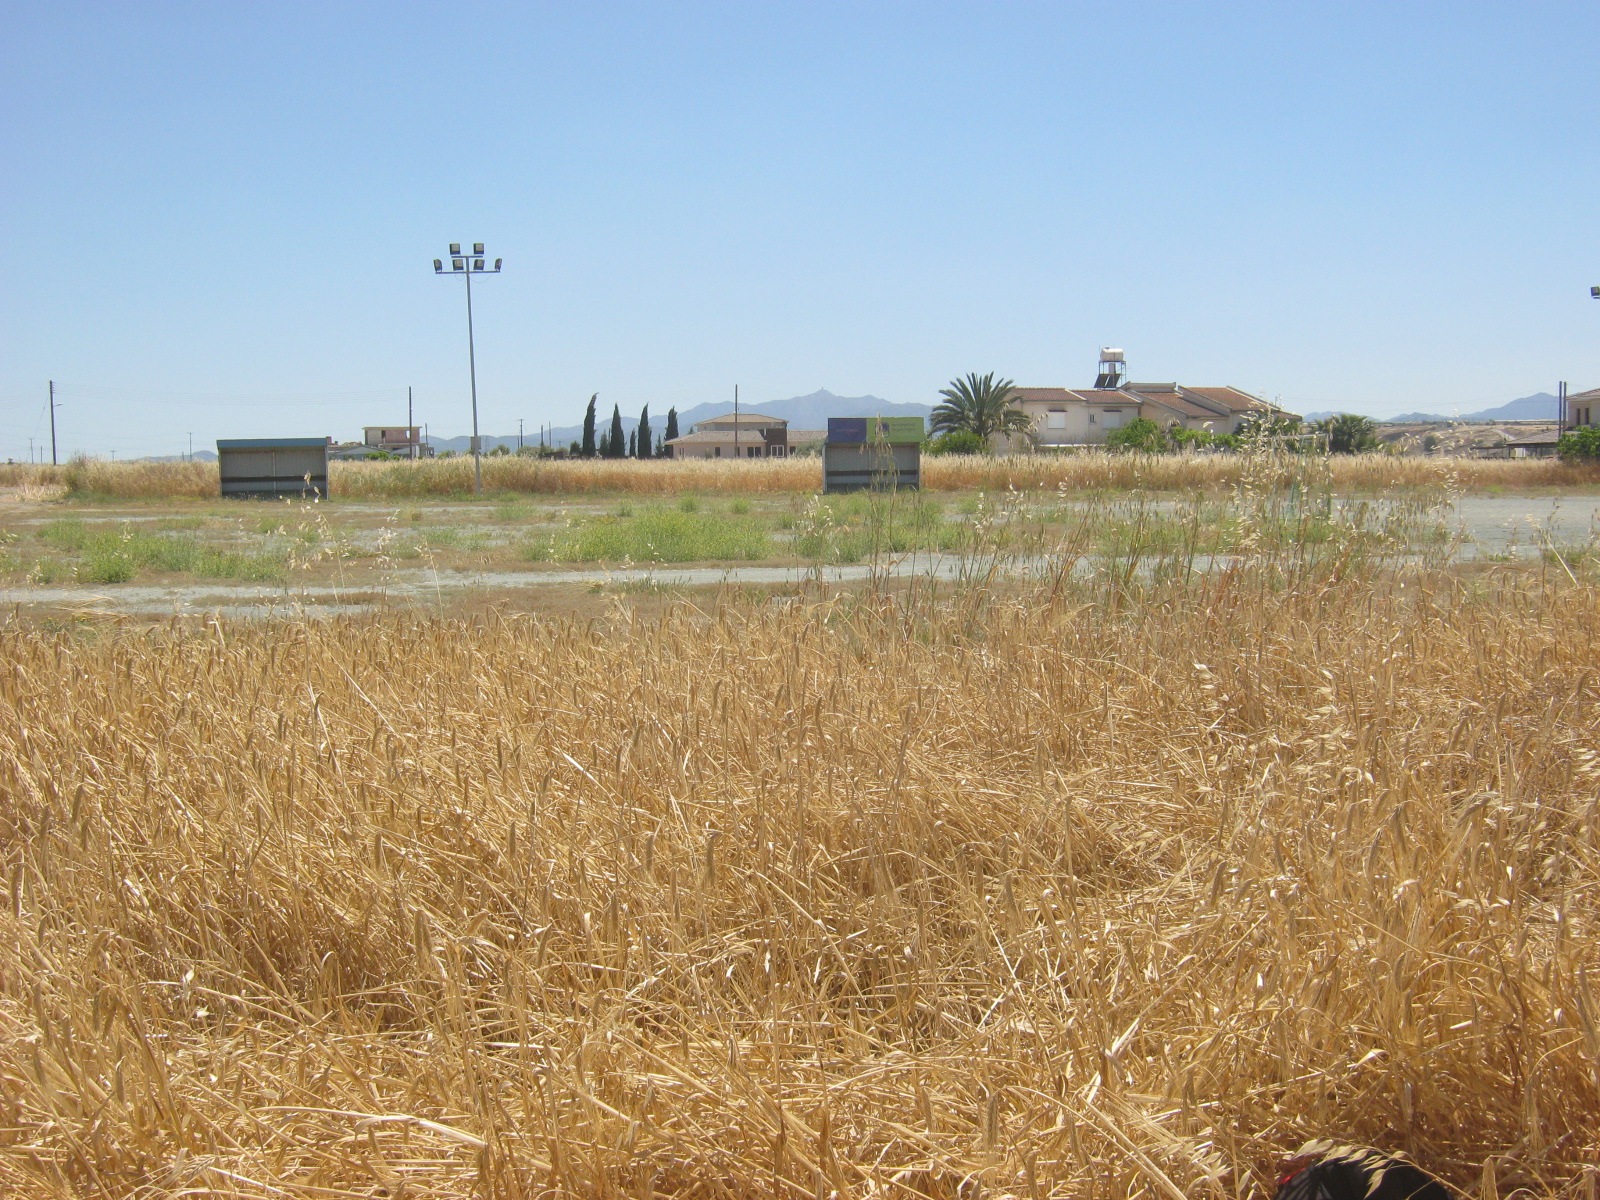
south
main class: Cropland
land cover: Barley
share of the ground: > 75 %
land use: Agriculture (excluding fallow land and kitchen gardens)
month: May
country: CY
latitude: 35.1136
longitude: 33.2163
